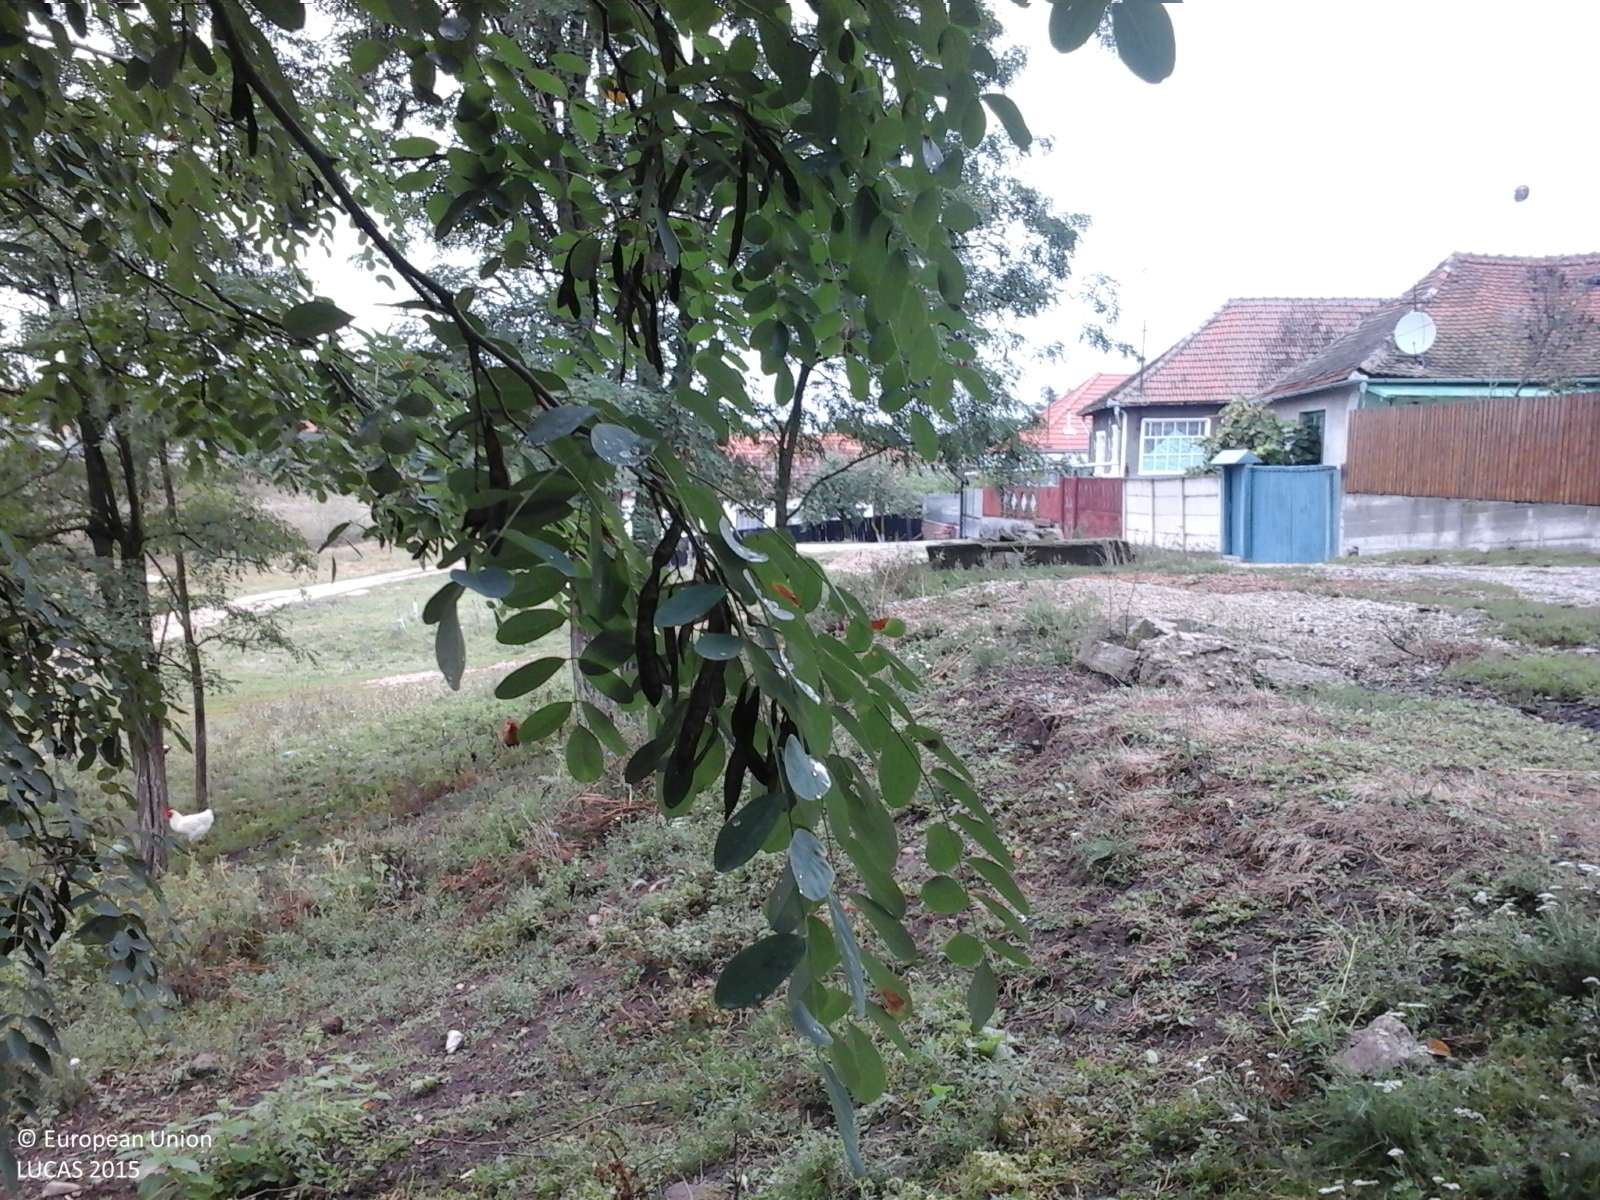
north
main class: Woodland
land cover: Broadleaved woodland
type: exotic forest
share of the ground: > 75 %
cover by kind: broadleaved forest trees 100 %
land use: Forestry
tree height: > 5 m
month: September
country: RO
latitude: 46.8411
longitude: 21.8053
